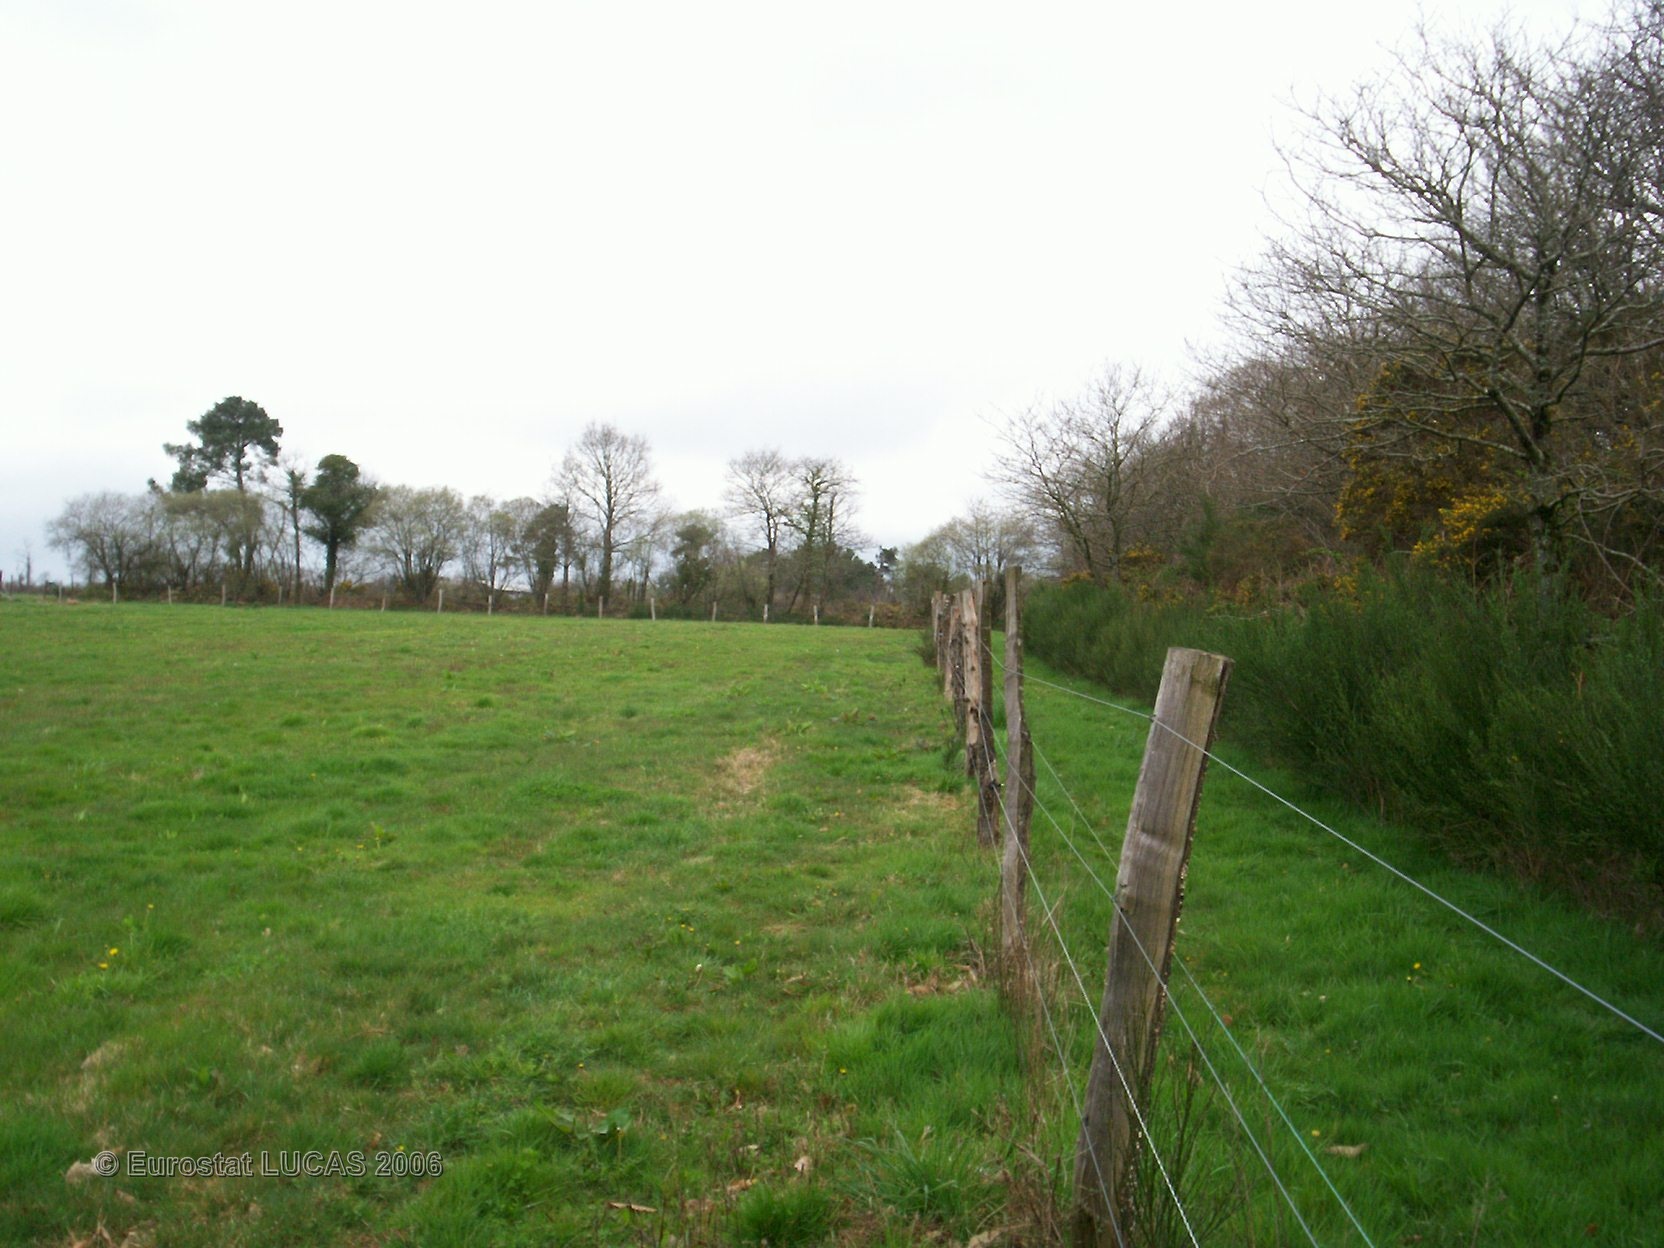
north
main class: Grassland
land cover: Grassland without tree/shrub cover
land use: Agriculture (excluding fallow land and kitchen gardens)
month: April
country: FR
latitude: 47.8114
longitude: -2.8712
